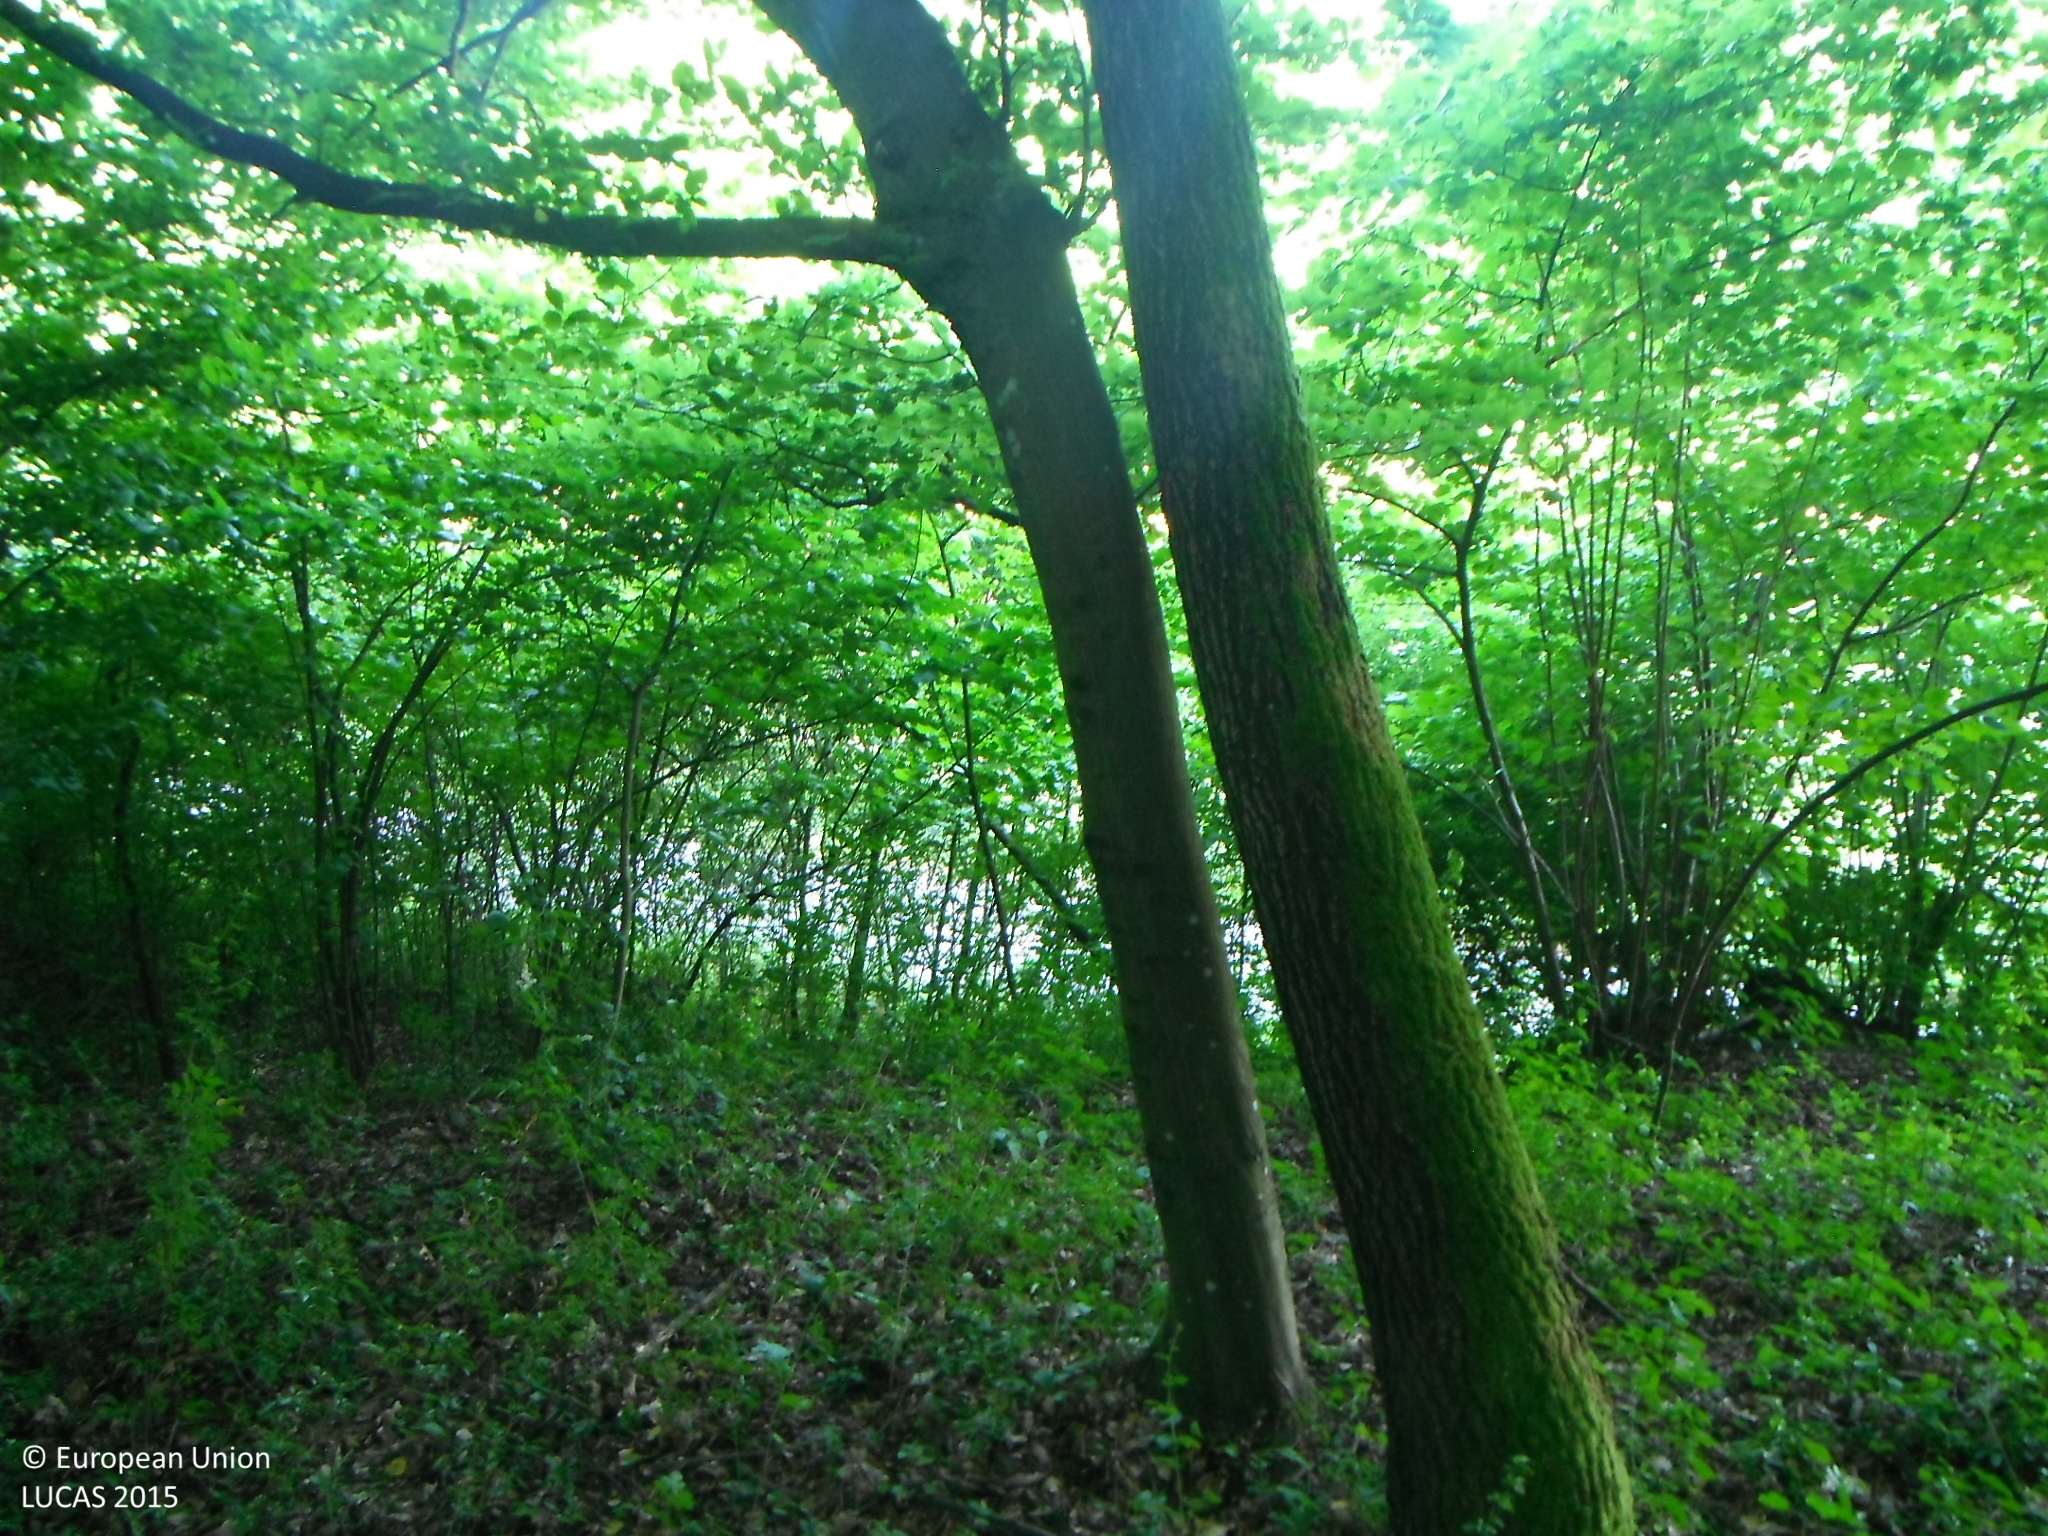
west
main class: Woodland
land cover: Broadleaved woodland
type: mesophytic deciduous forest
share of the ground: > 75 %
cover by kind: broadleaved forest trees 100 %
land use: Forestry
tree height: > 5 m
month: June
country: SK
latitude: 48.2794
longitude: 18.8995
